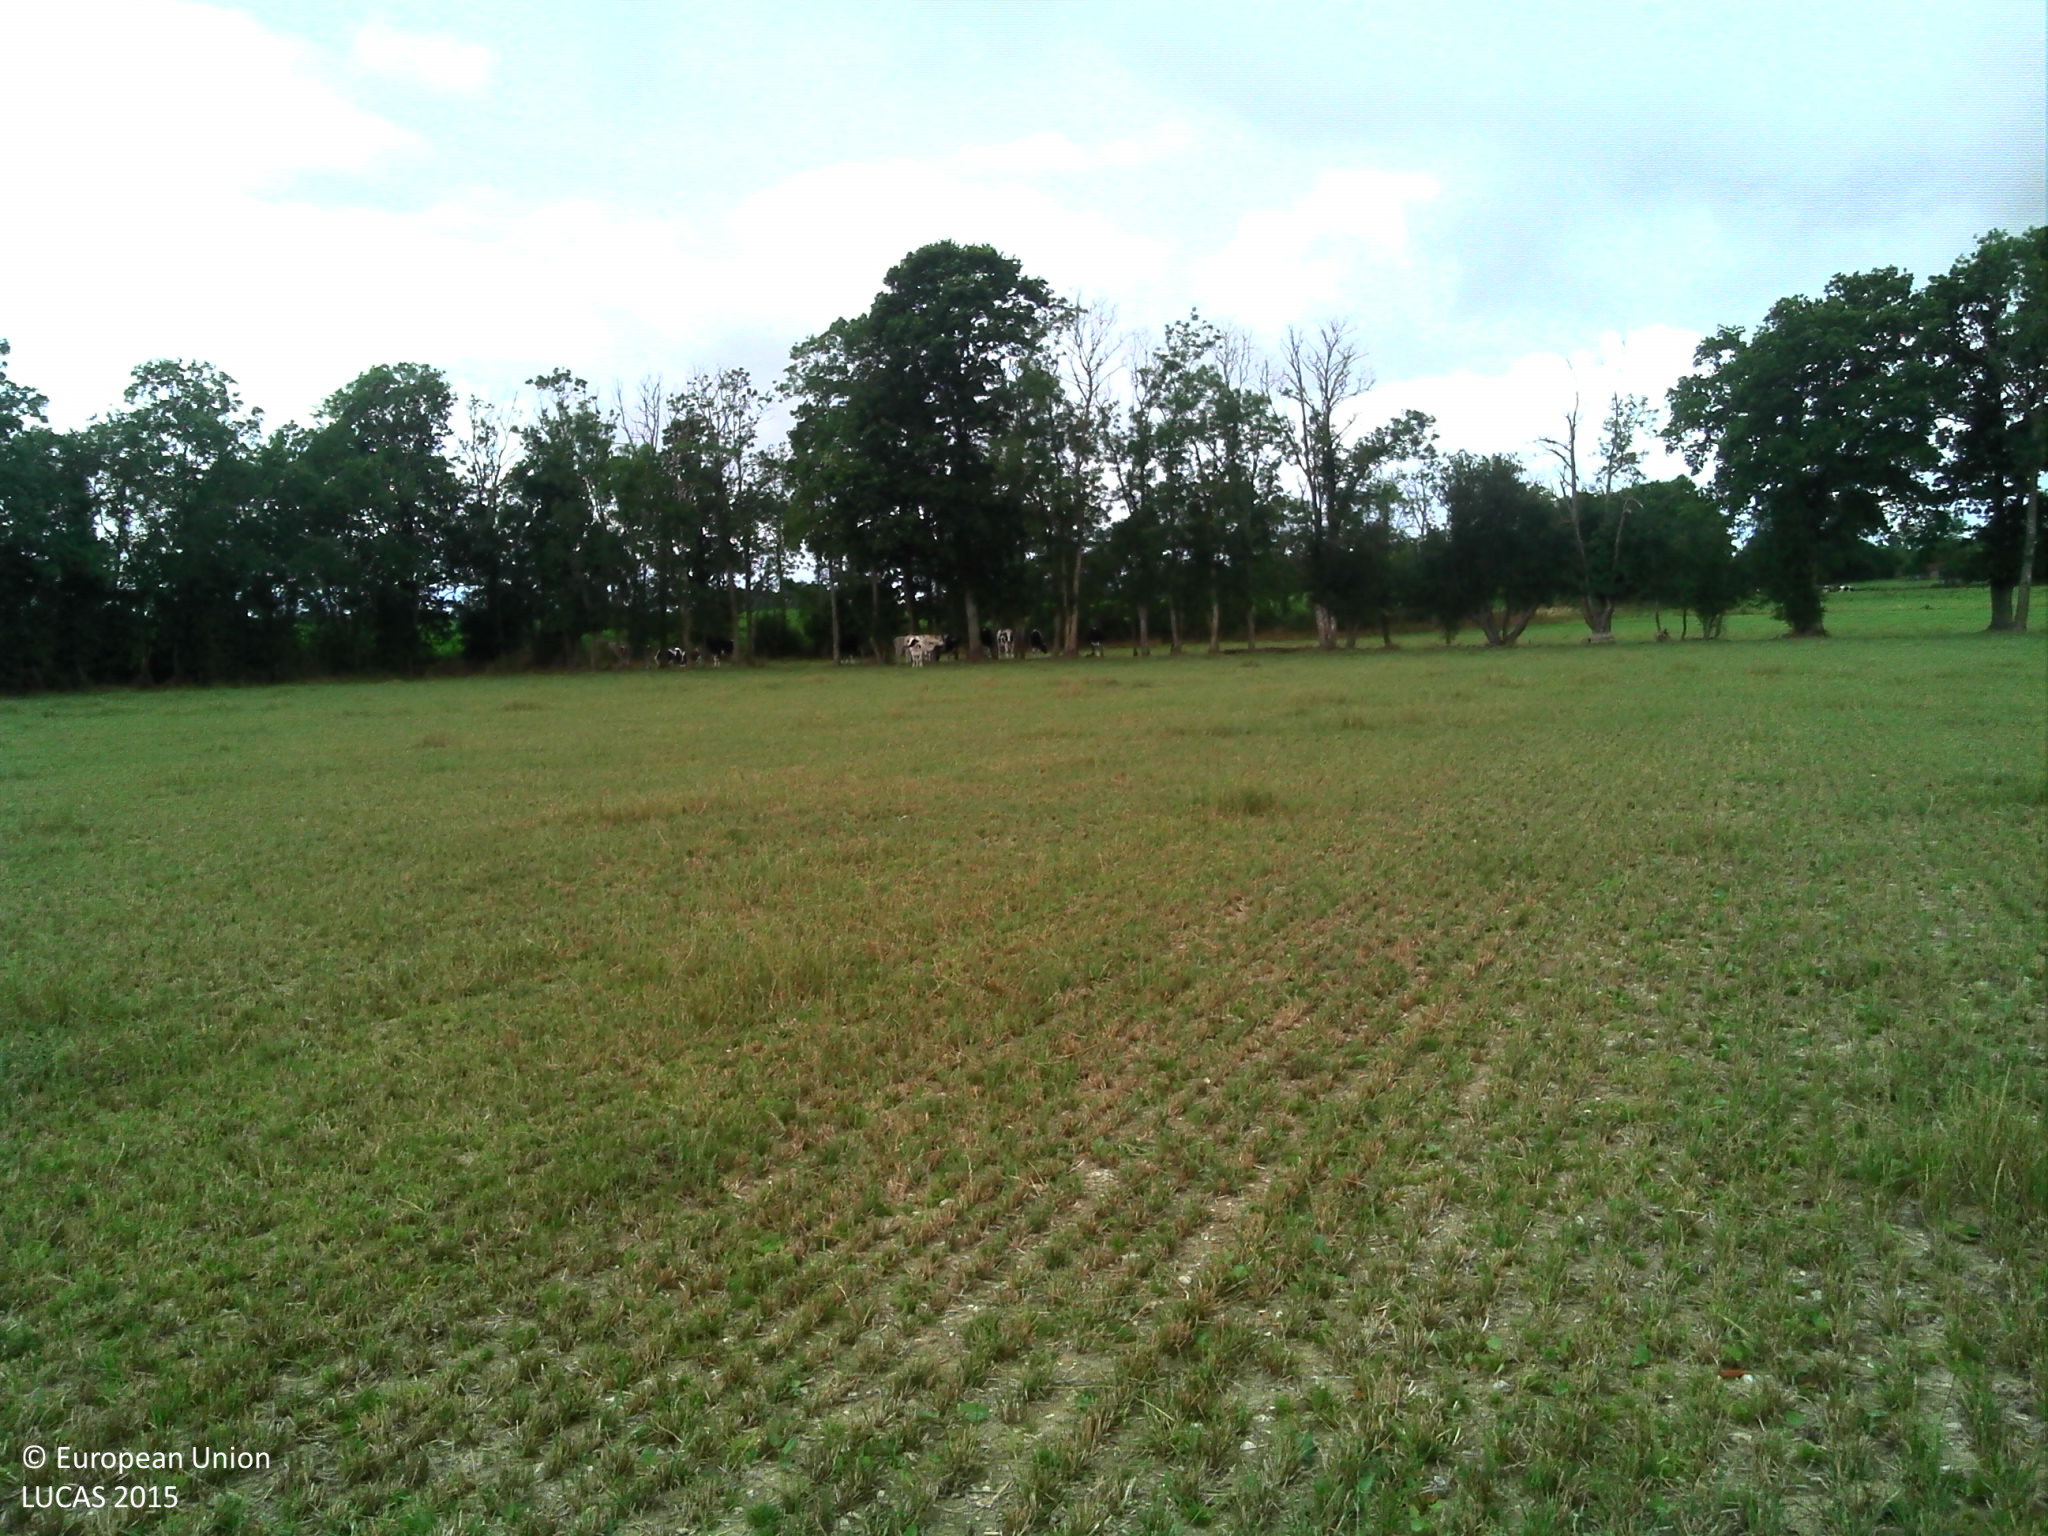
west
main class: Grassland
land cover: Grassland without tree/shrub cover
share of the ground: > 75 %
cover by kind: herbaceous plants 100 %
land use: Agriculture (excluding fallow land and kitchen gardens)
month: July
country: FR
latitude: 48.8477
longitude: 0.5310
